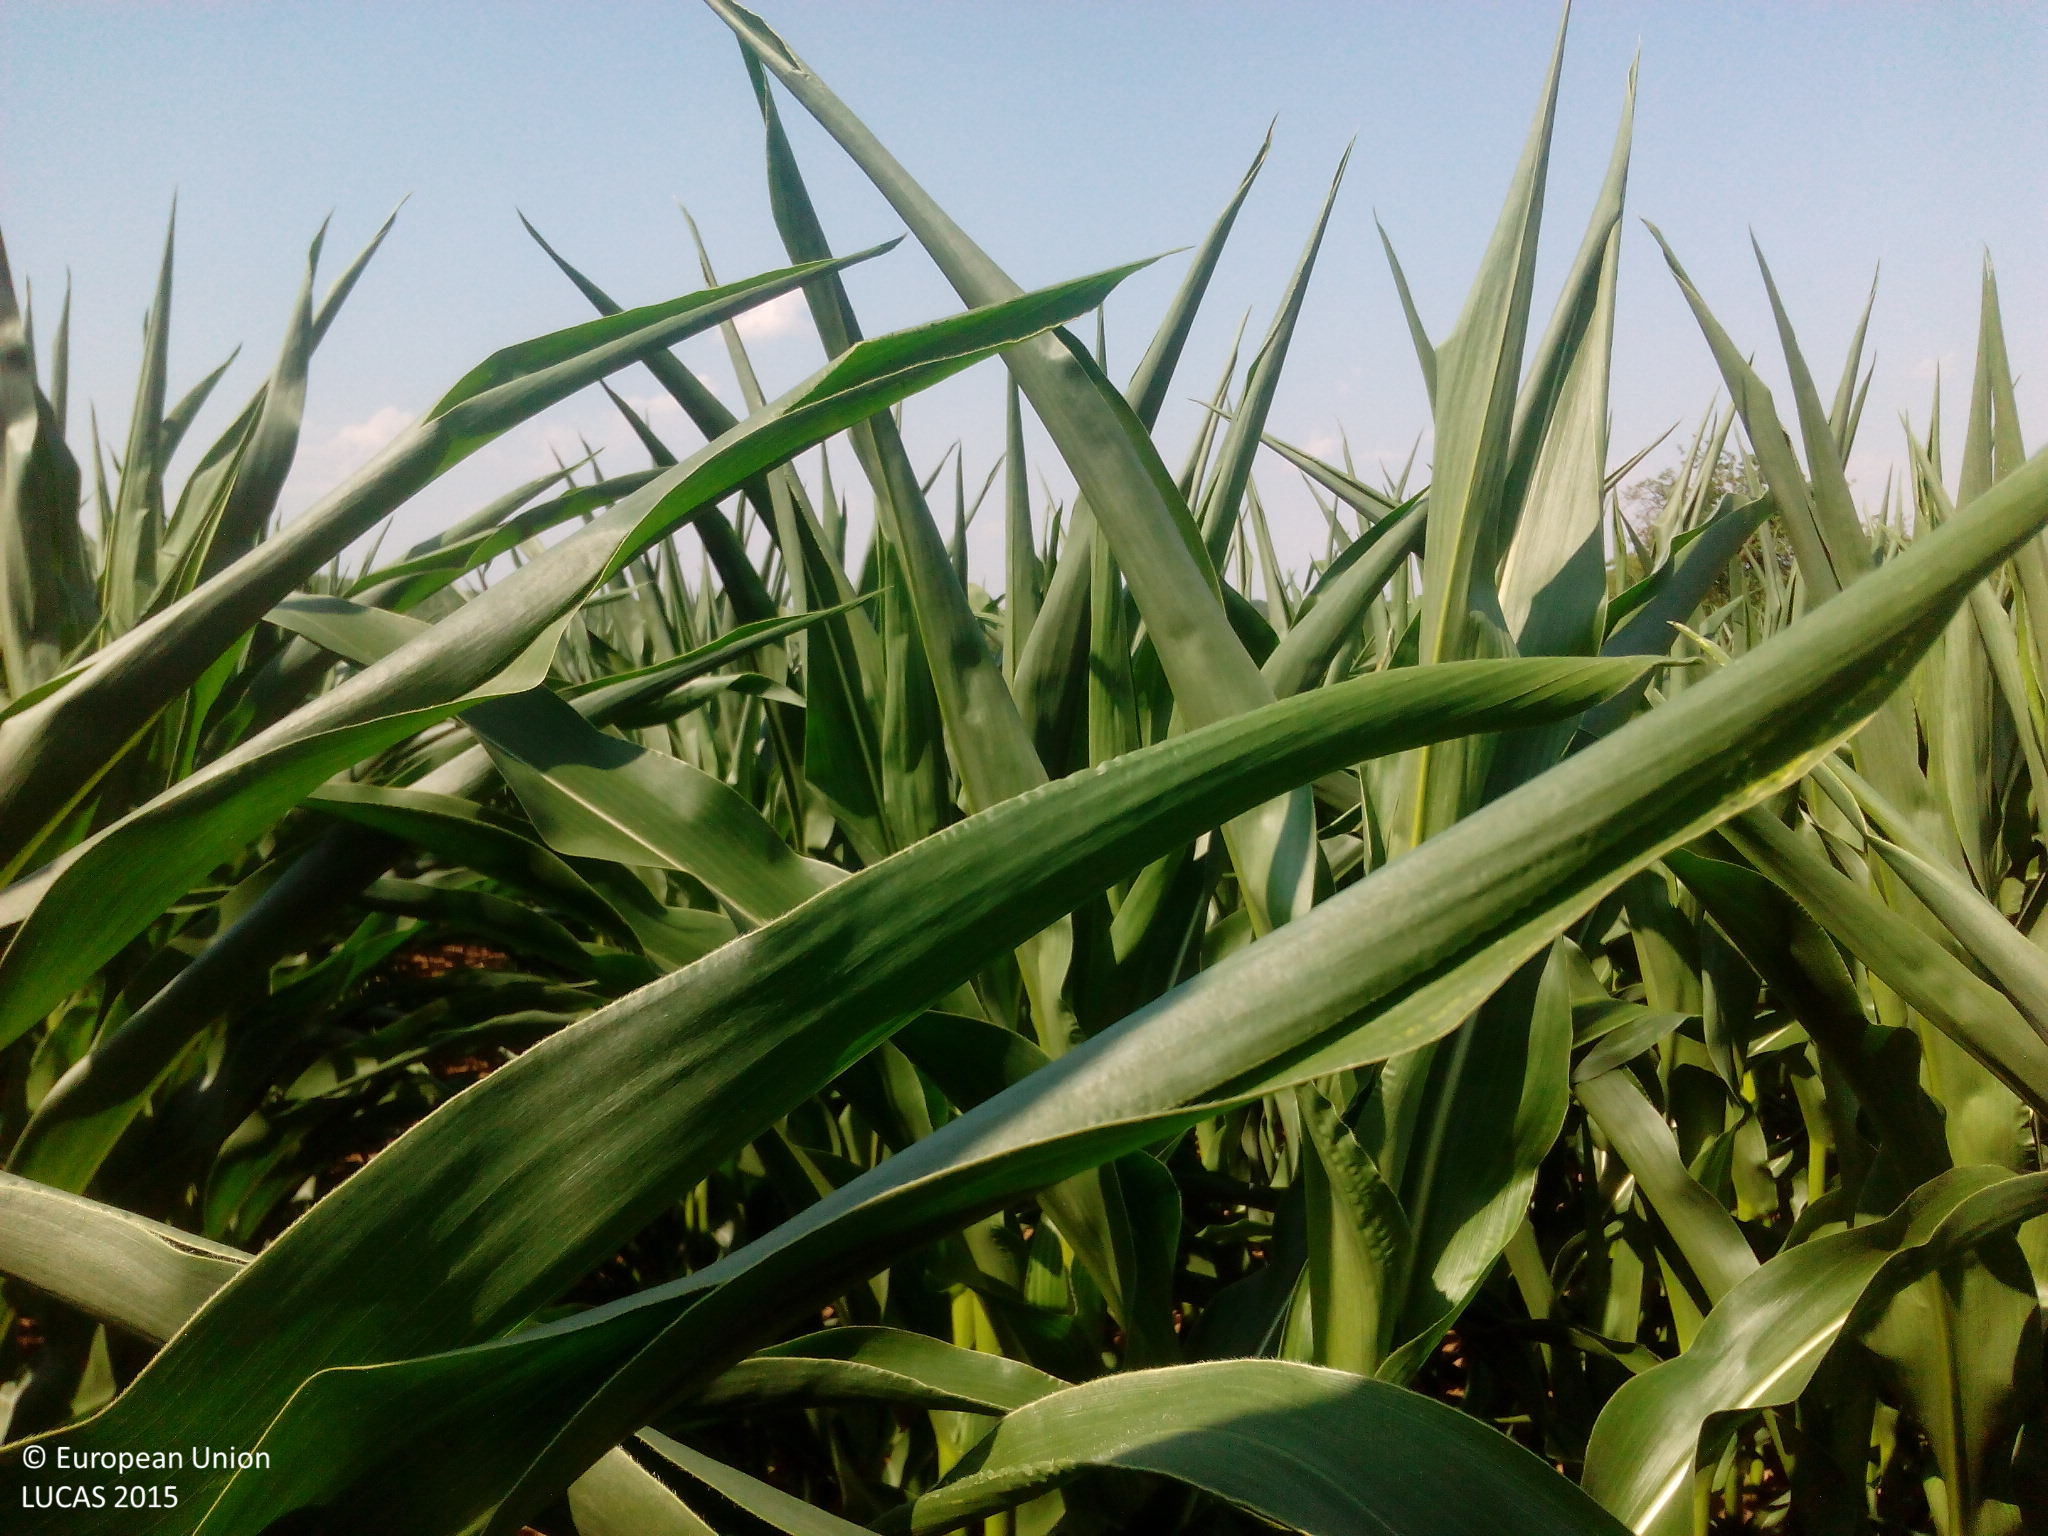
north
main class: Cropland
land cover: Maize
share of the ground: > 75 %
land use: Agriculture (excluding fallow land and kitchen gardens)
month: July
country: DE
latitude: 49.4468
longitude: 9.9035
